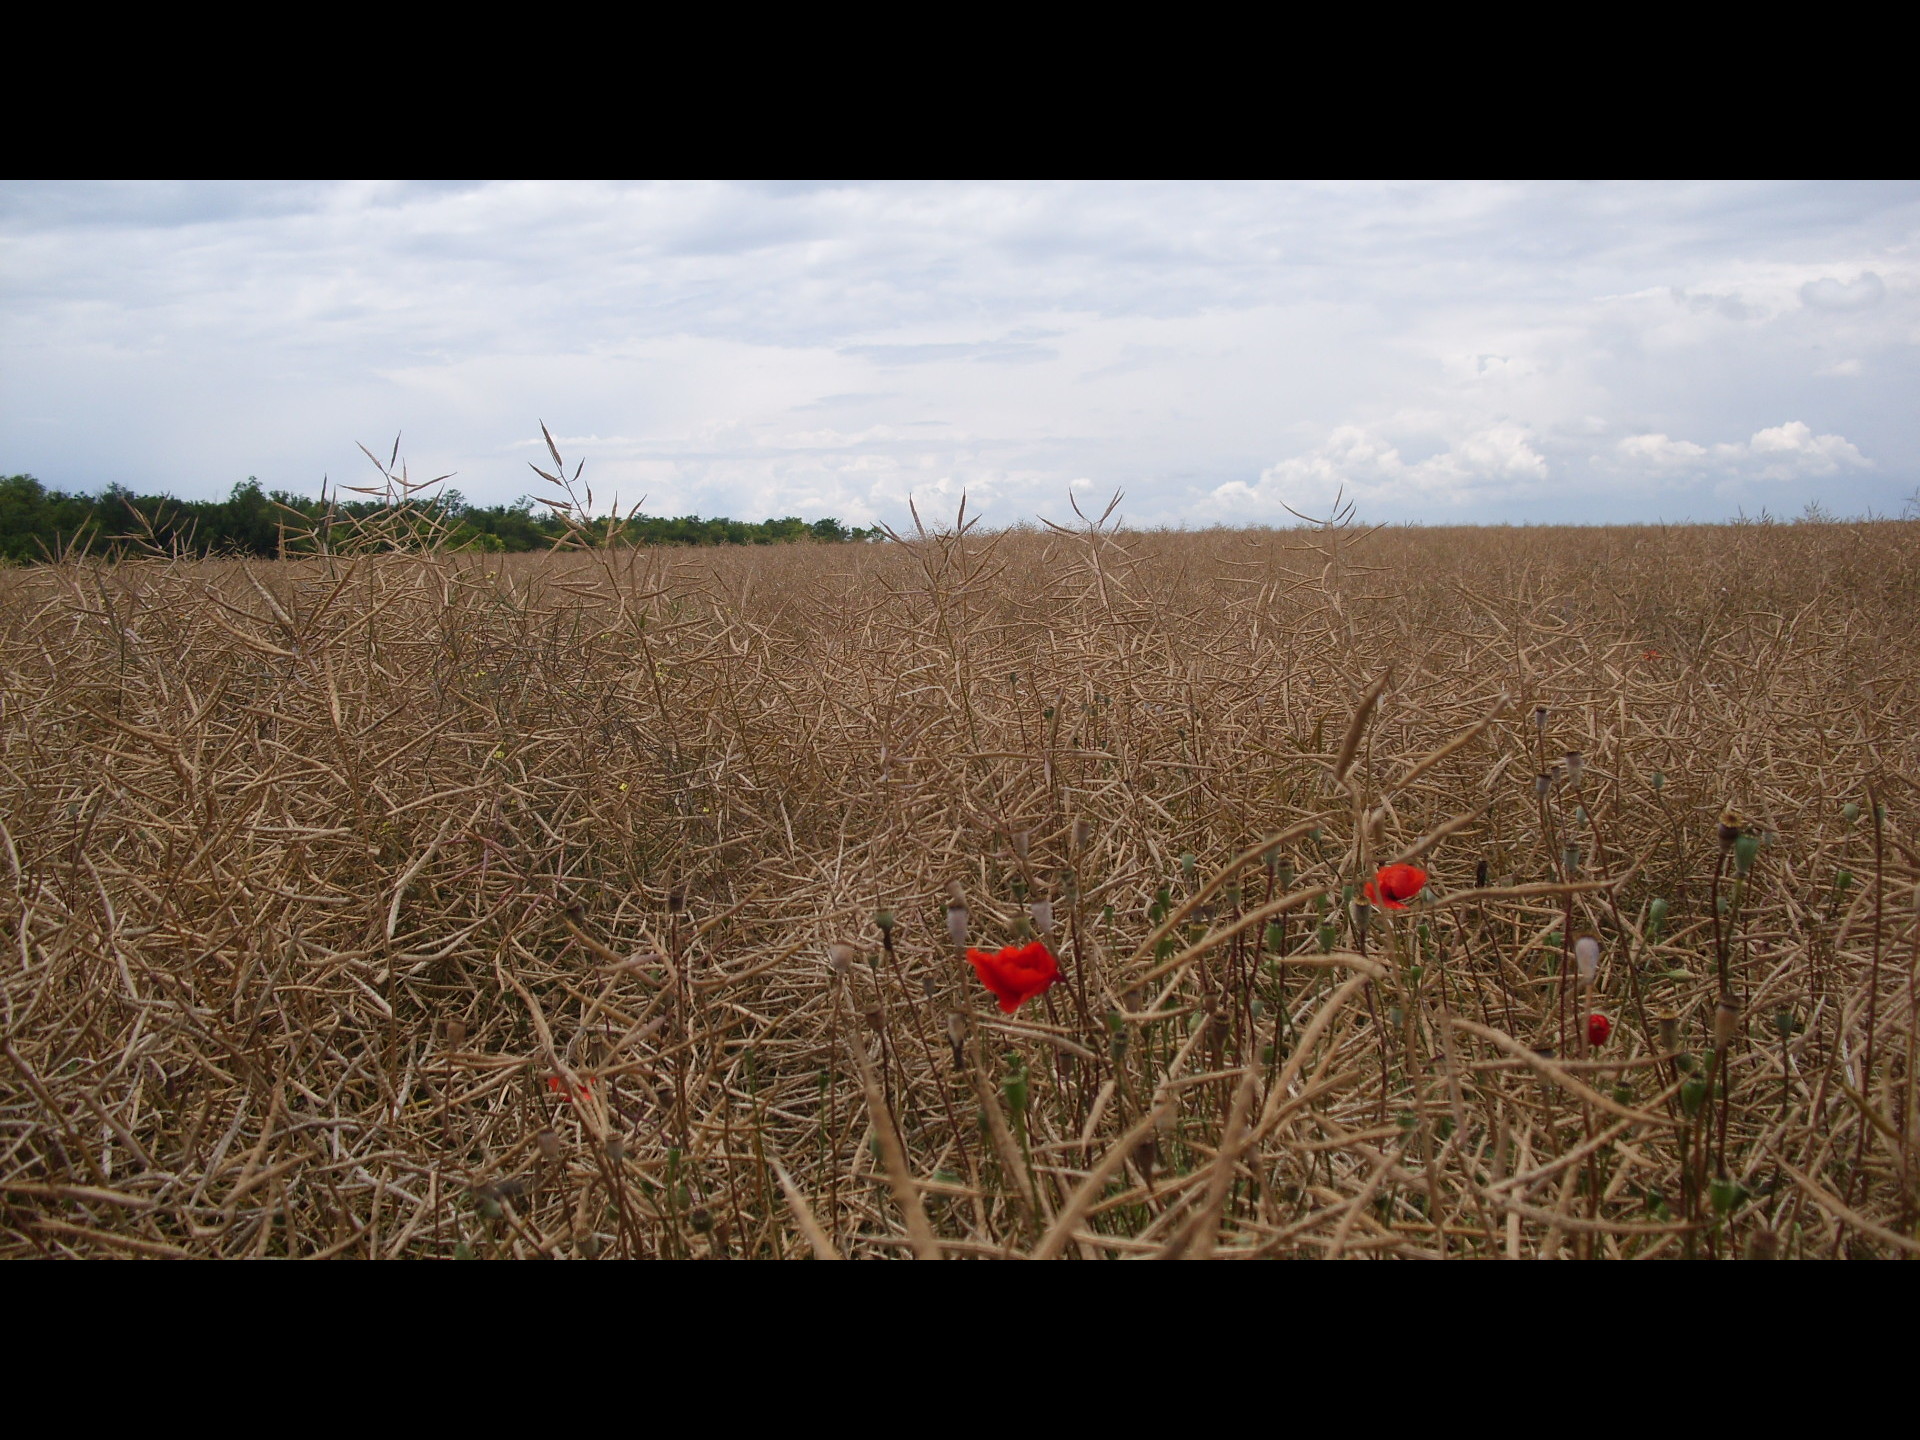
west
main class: Cropland
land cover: Rape and turnip rape
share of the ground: > 75 %
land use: Agriculture (excluding fallow land and kitchen gardens)
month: June
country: BG
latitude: 43.6371
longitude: 23.5705
